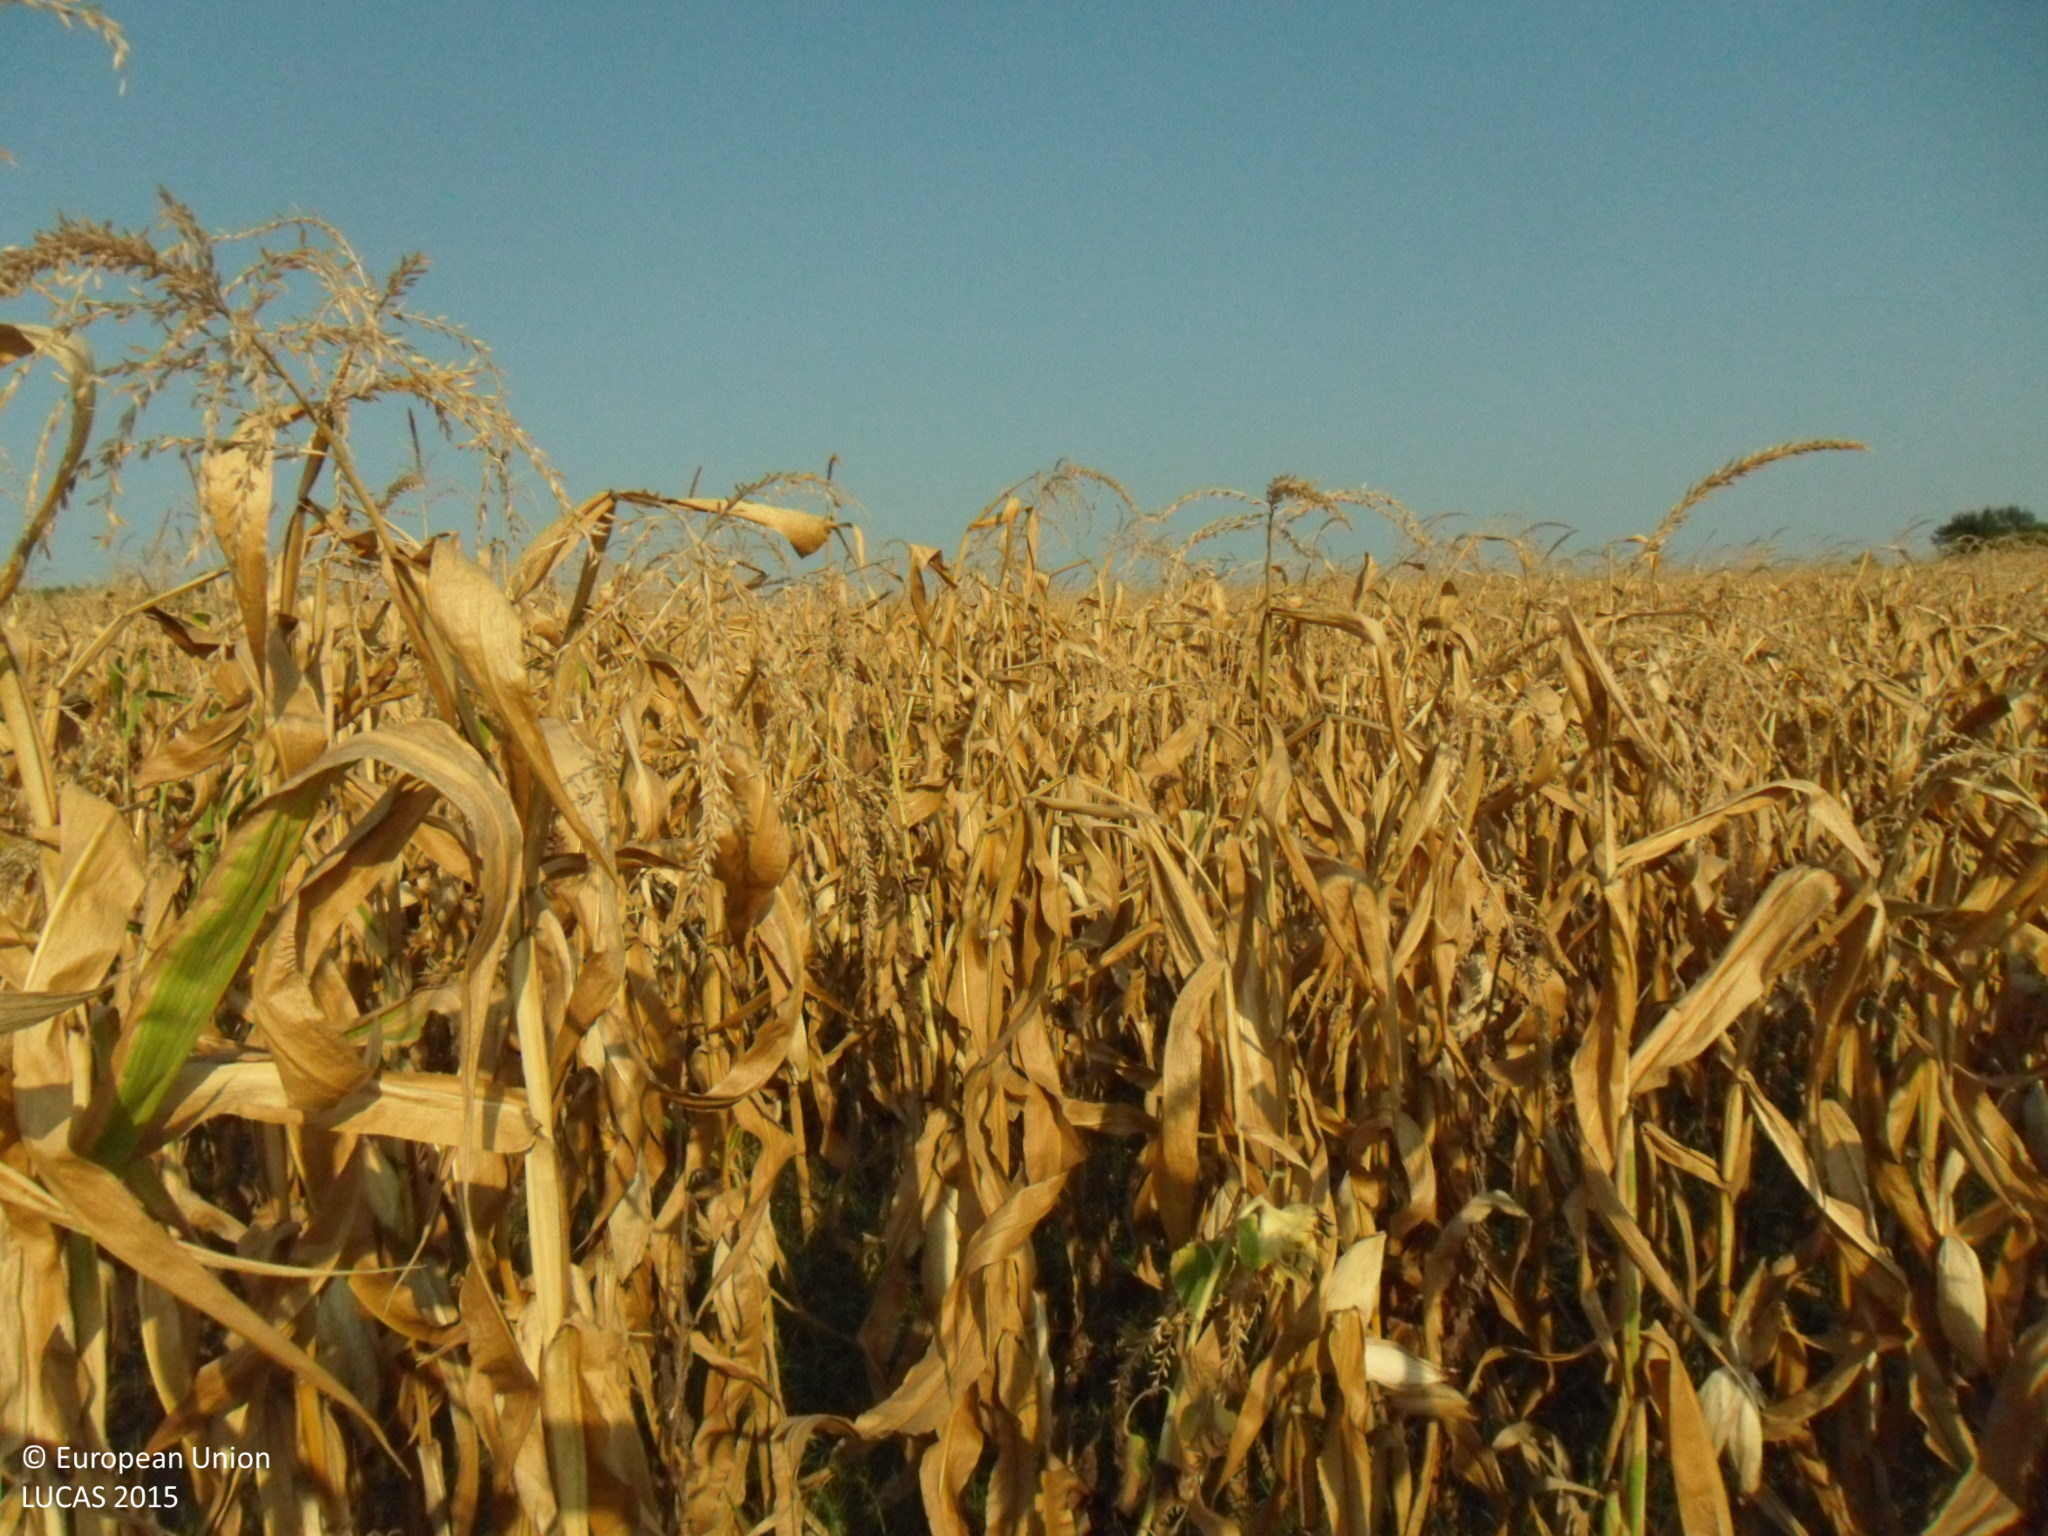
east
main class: Cropland
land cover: Maize
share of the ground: > 75 %
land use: Agriculture (excluding fallow land and kitchen gardens)
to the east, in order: Maize
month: September
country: BG
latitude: 43.5524
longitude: 26.6080
